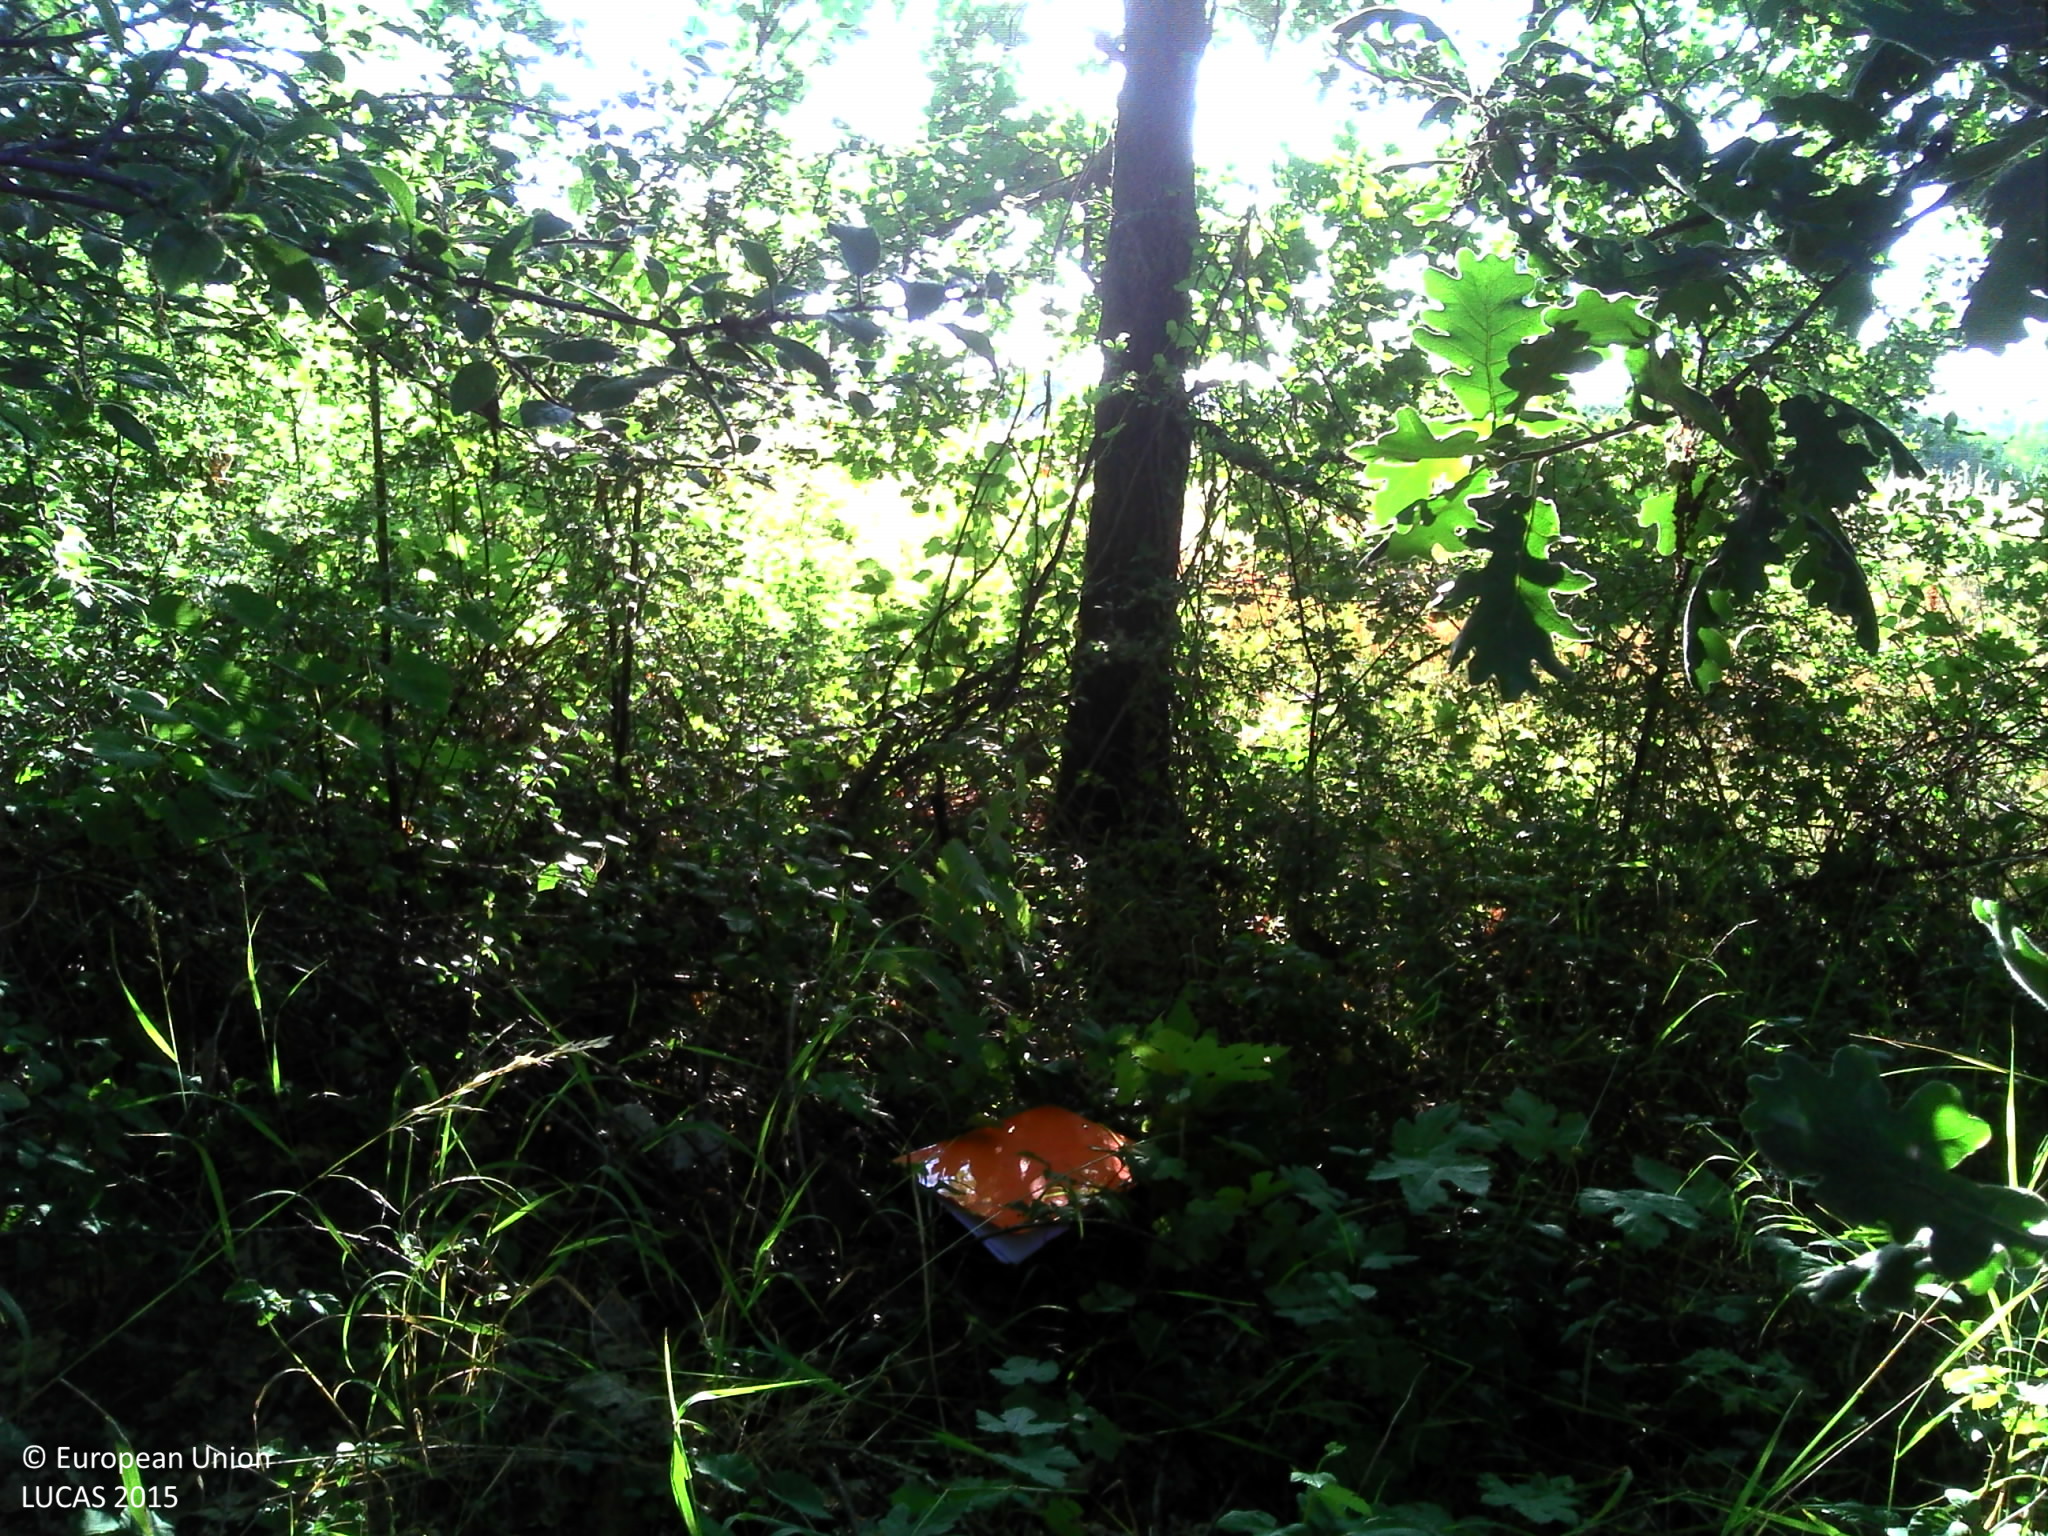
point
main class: Shrubland
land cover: Shrubland with sparse tree cover
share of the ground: > 75 %
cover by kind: herbaceous plants 50 %, shrubs 45 %, broadleaved forest trees 5 %
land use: Semi-natural and natural areas not in use
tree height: > 5 m
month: June
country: FR
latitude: 43.6410
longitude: 1.3119
